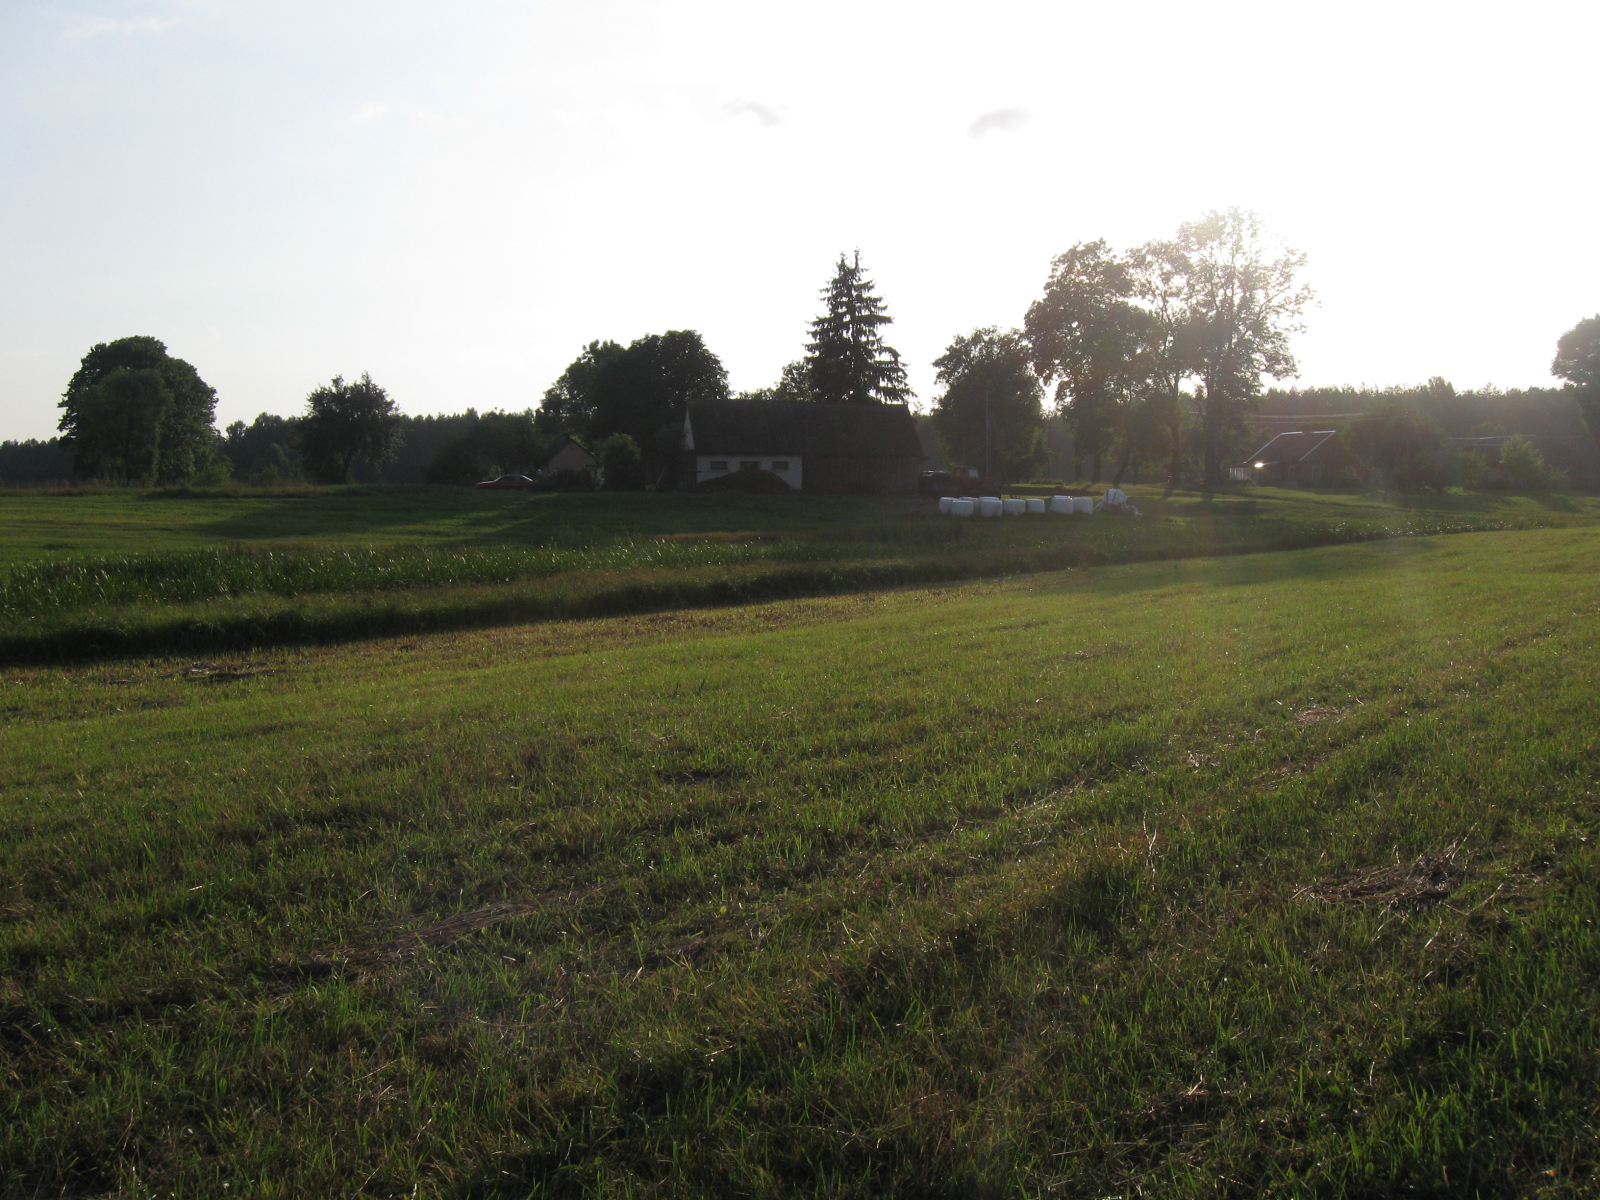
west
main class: Grassland
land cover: Grassland without tree/shrub cover
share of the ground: > 75 %
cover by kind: herbaceous plants 100 %
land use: Agriculture (excluding fallow land and kitchen gardens)
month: July
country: LT
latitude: 54.0394
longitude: 23.7234
